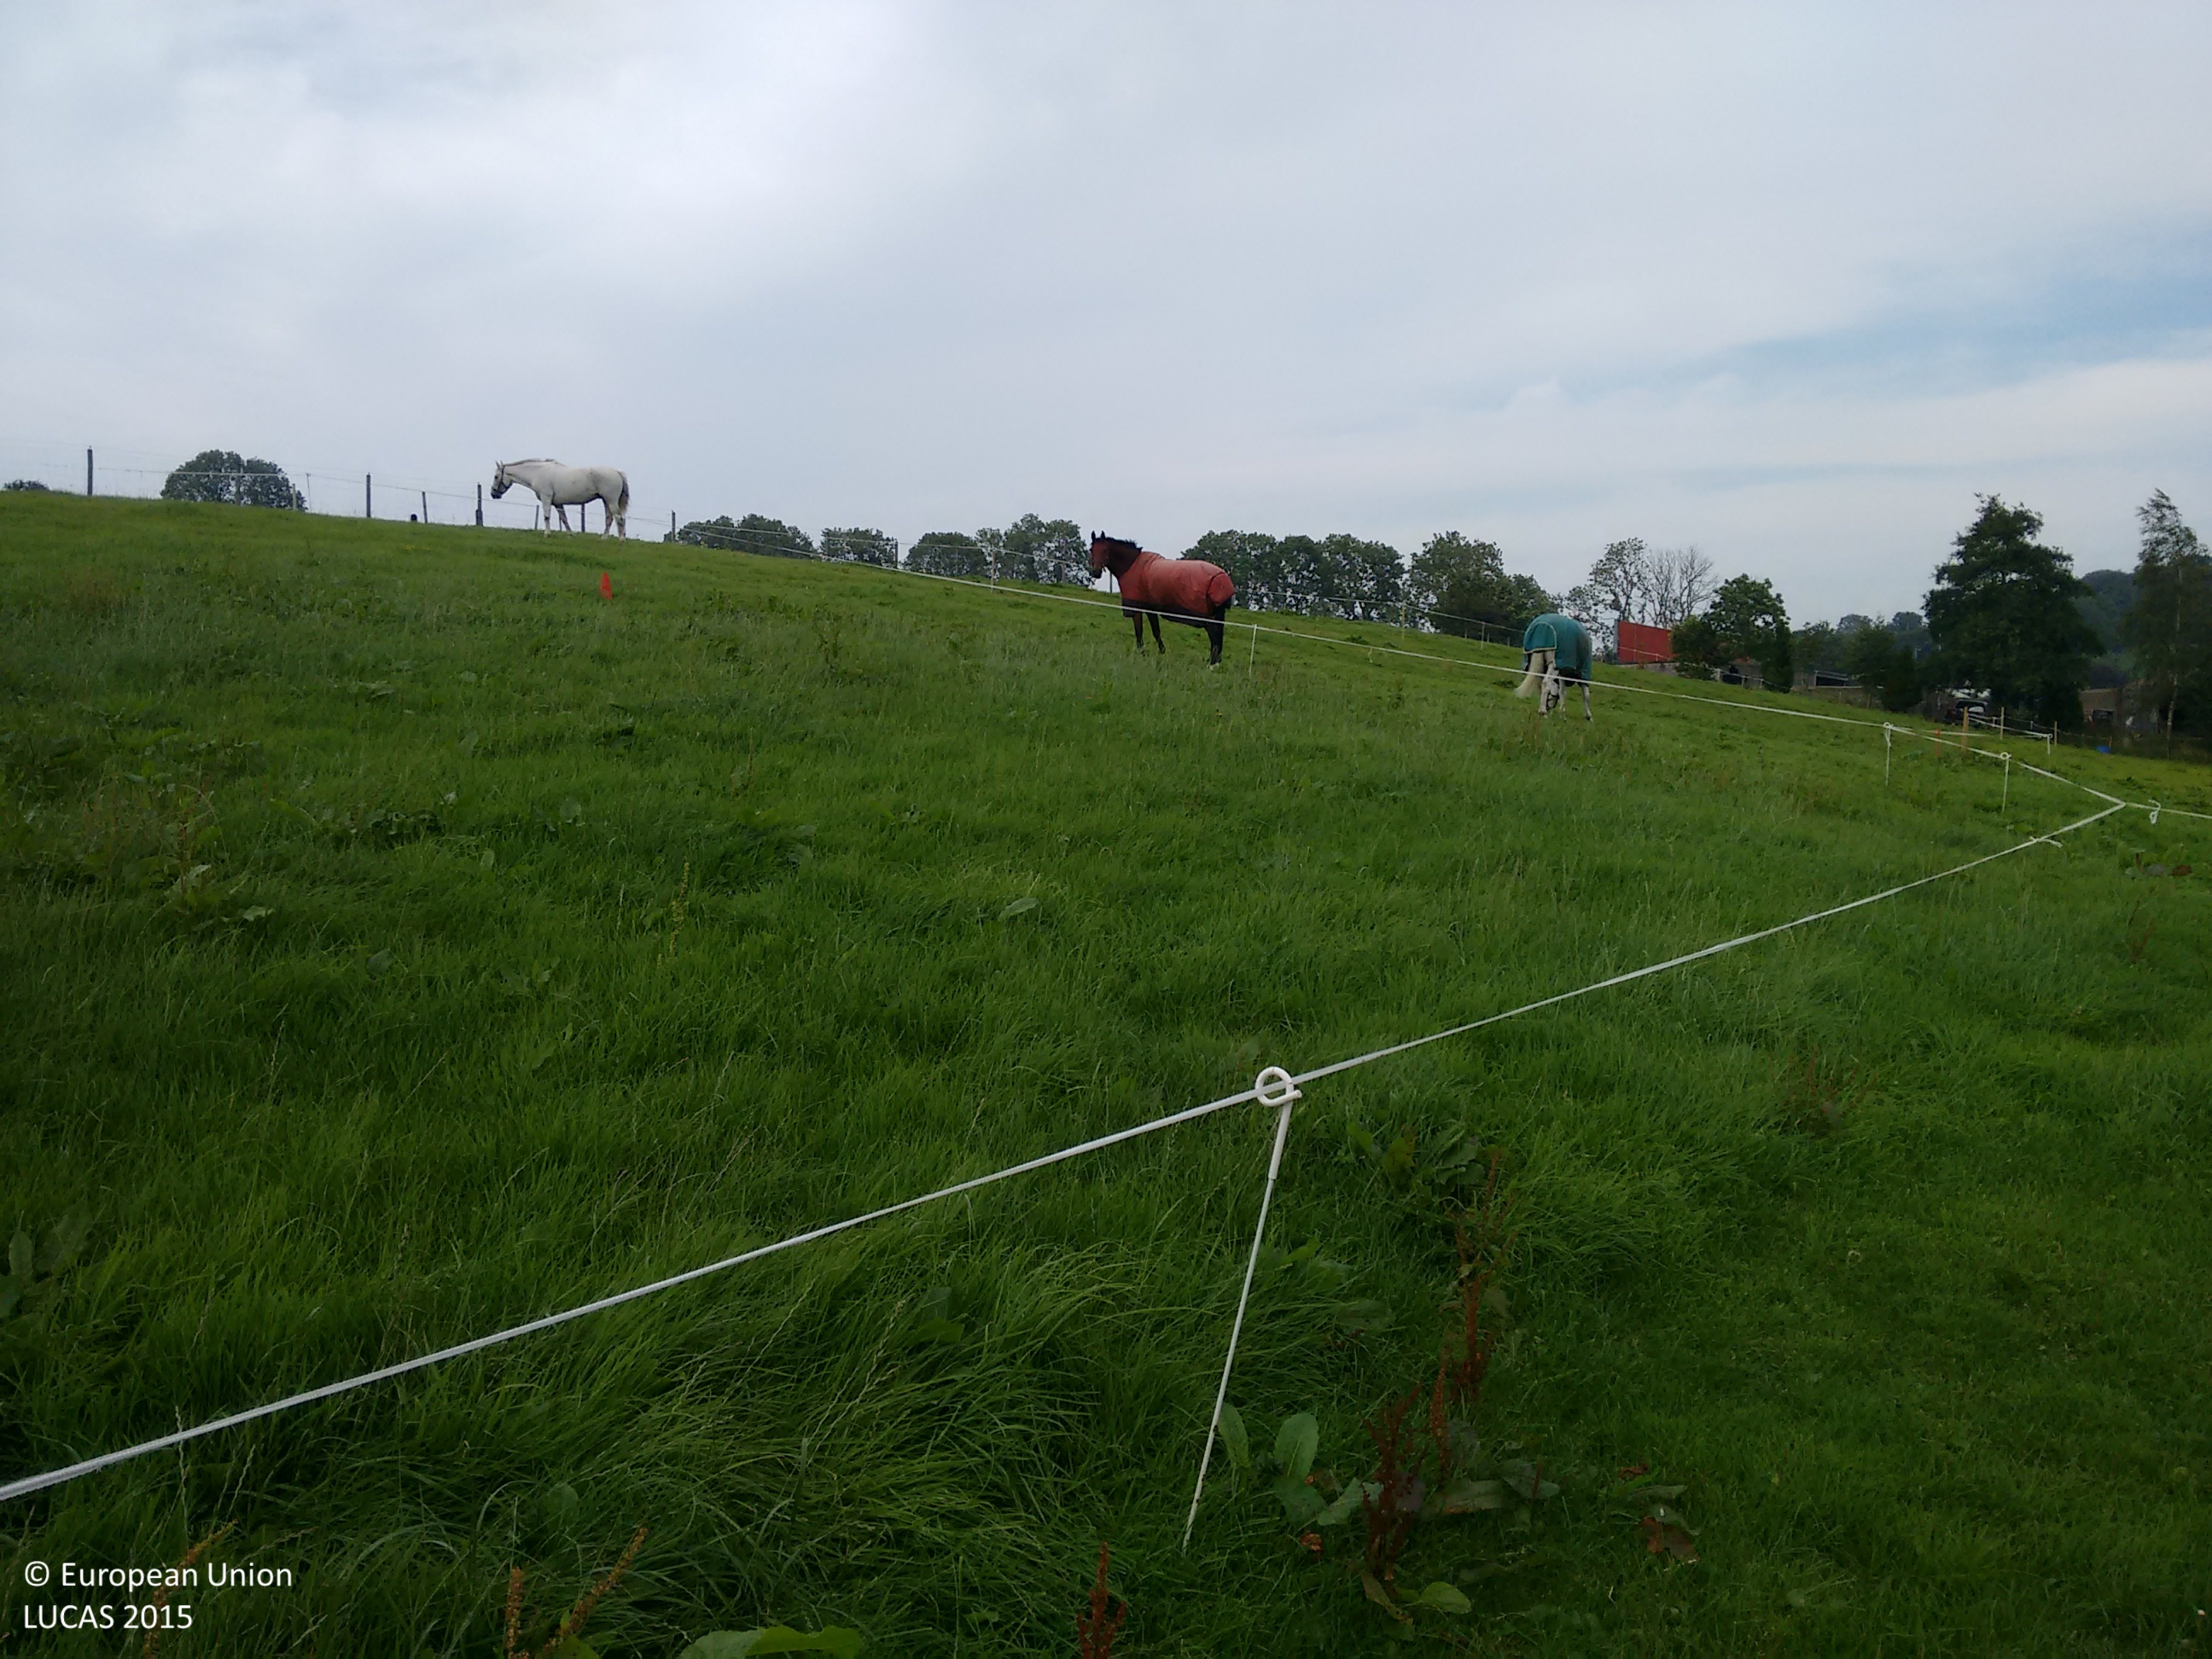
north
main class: Grassland
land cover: Grassland without tree/shrub cover
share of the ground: > 75 %
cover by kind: herbaceous plants 100 %
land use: Agriculture (excluding fallow land and kitchen gardens)
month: September
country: IE
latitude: 54.3163
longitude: -6.9086
